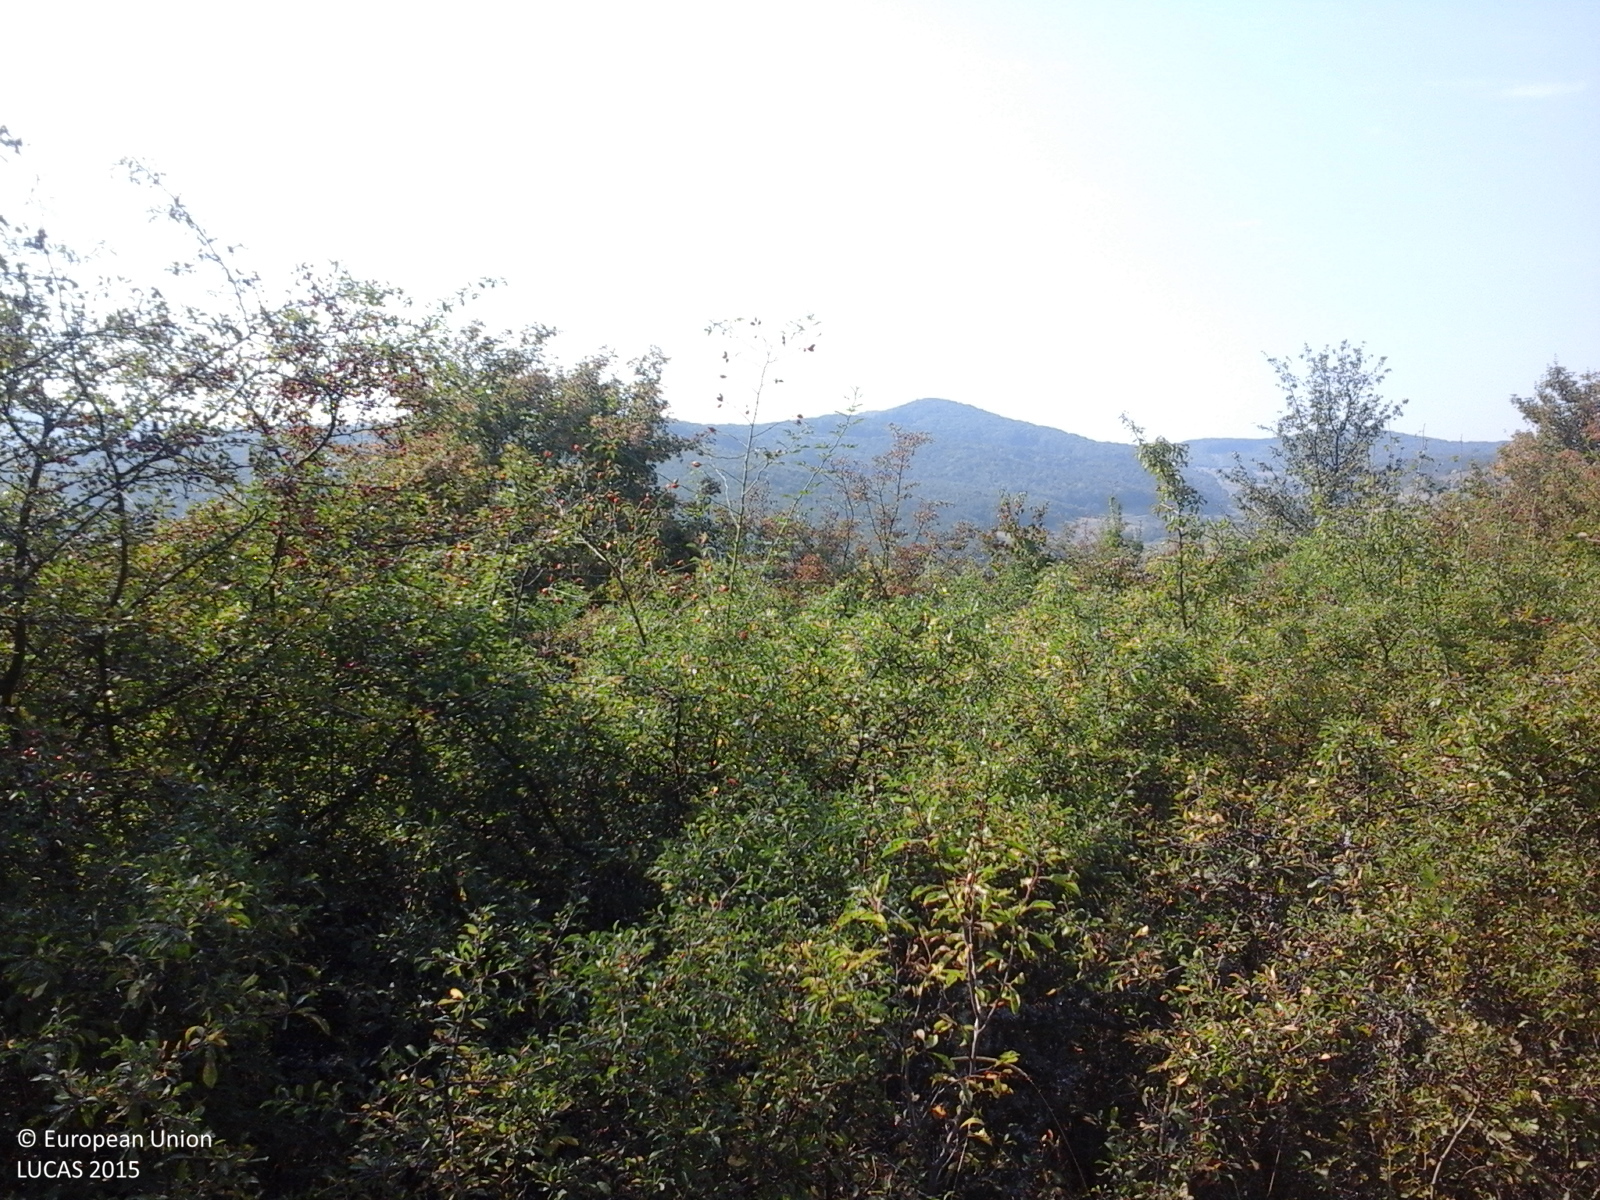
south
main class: Shrubland
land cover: Shrubland with sparse tree cover
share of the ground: > 75 %
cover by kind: shrubs 95 %, broadleaved forest trees 5 %
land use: Semi-natural and natural areas not in use
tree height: < 5 m
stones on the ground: < 10 %
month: September
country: RO
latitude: 47.0036
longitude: 24.4915
